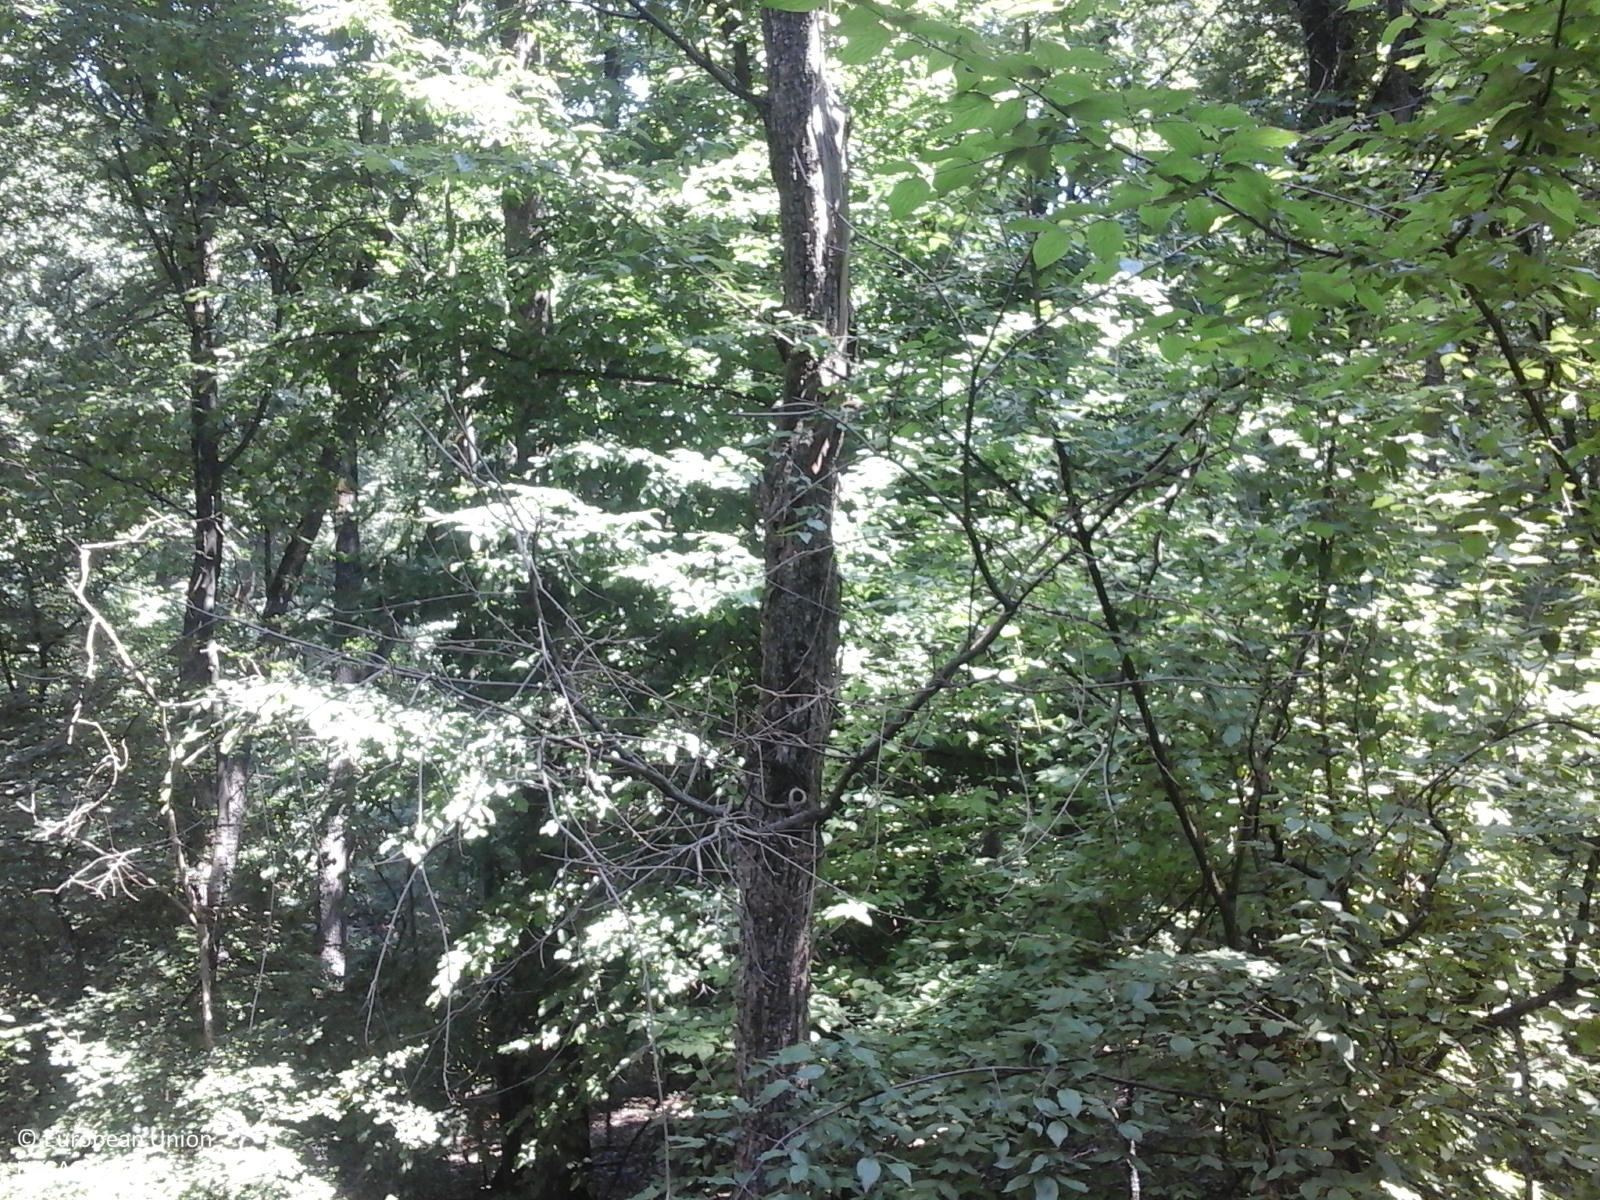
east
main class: Woodland
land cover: Broadleaved woodland
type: beech forest
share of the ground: > 75 %
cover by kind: broadleaved forest trees 100 %
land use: Forestry
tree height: > 5 m
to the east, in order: Broadleaved woodland; Grassland without tree/shrub cover
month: July
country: RO
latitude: 44.7408
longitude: 24.4569
